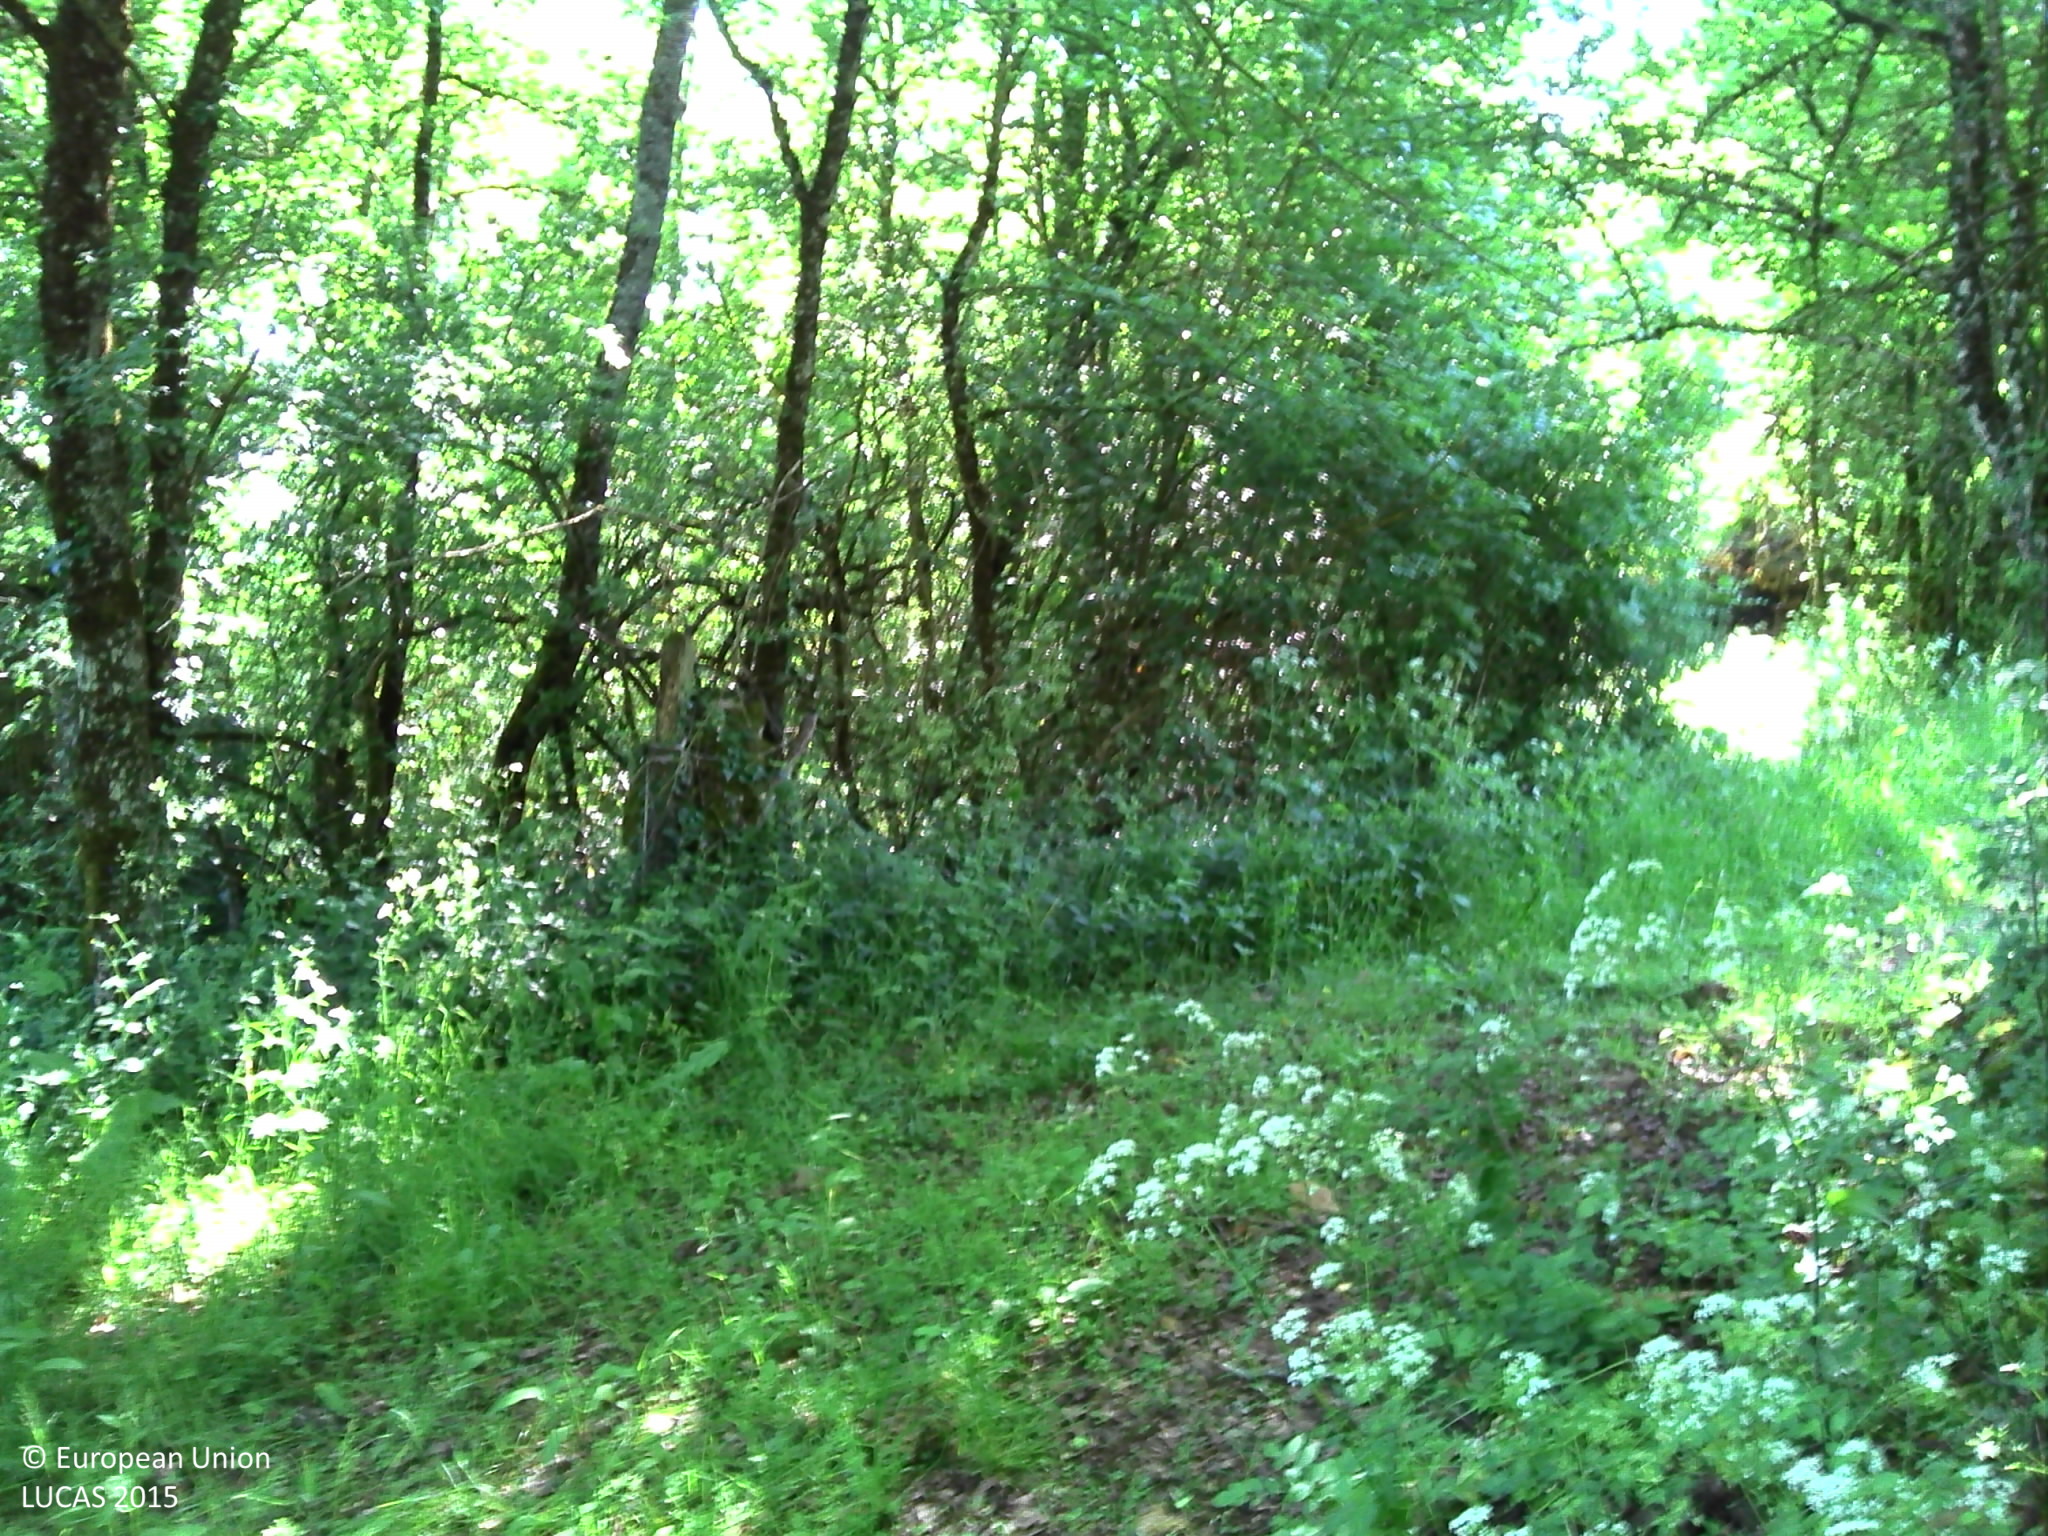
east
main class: Woodland
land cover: Broadleaved woodland
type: acidophilous oak and oak-birch forest
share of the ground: > 75 %
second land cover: Grassland without tree/shrub cover
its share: 50 - 75 %
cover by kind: broadleaved forest trees 60 %, herbaceous plants 35 %, lichens and mosses 5 %
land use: Forestry
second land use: Agriculture (excluding fallow land and kitchen gardens)
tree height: > 5 m
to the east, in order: Broadleaved woodland; Grassland without tree/shrub cover; Tracks; Broadleaved woodland; Grass margins; Paved roads, cycling and walking lanes; Grass margins; Fences; Broadleaved woodland; Grassland without tree/shrub cover; Electric lines; Grassland without tree/shrub cover
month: May
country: FR
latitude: 44.3910
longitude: 2.5589
